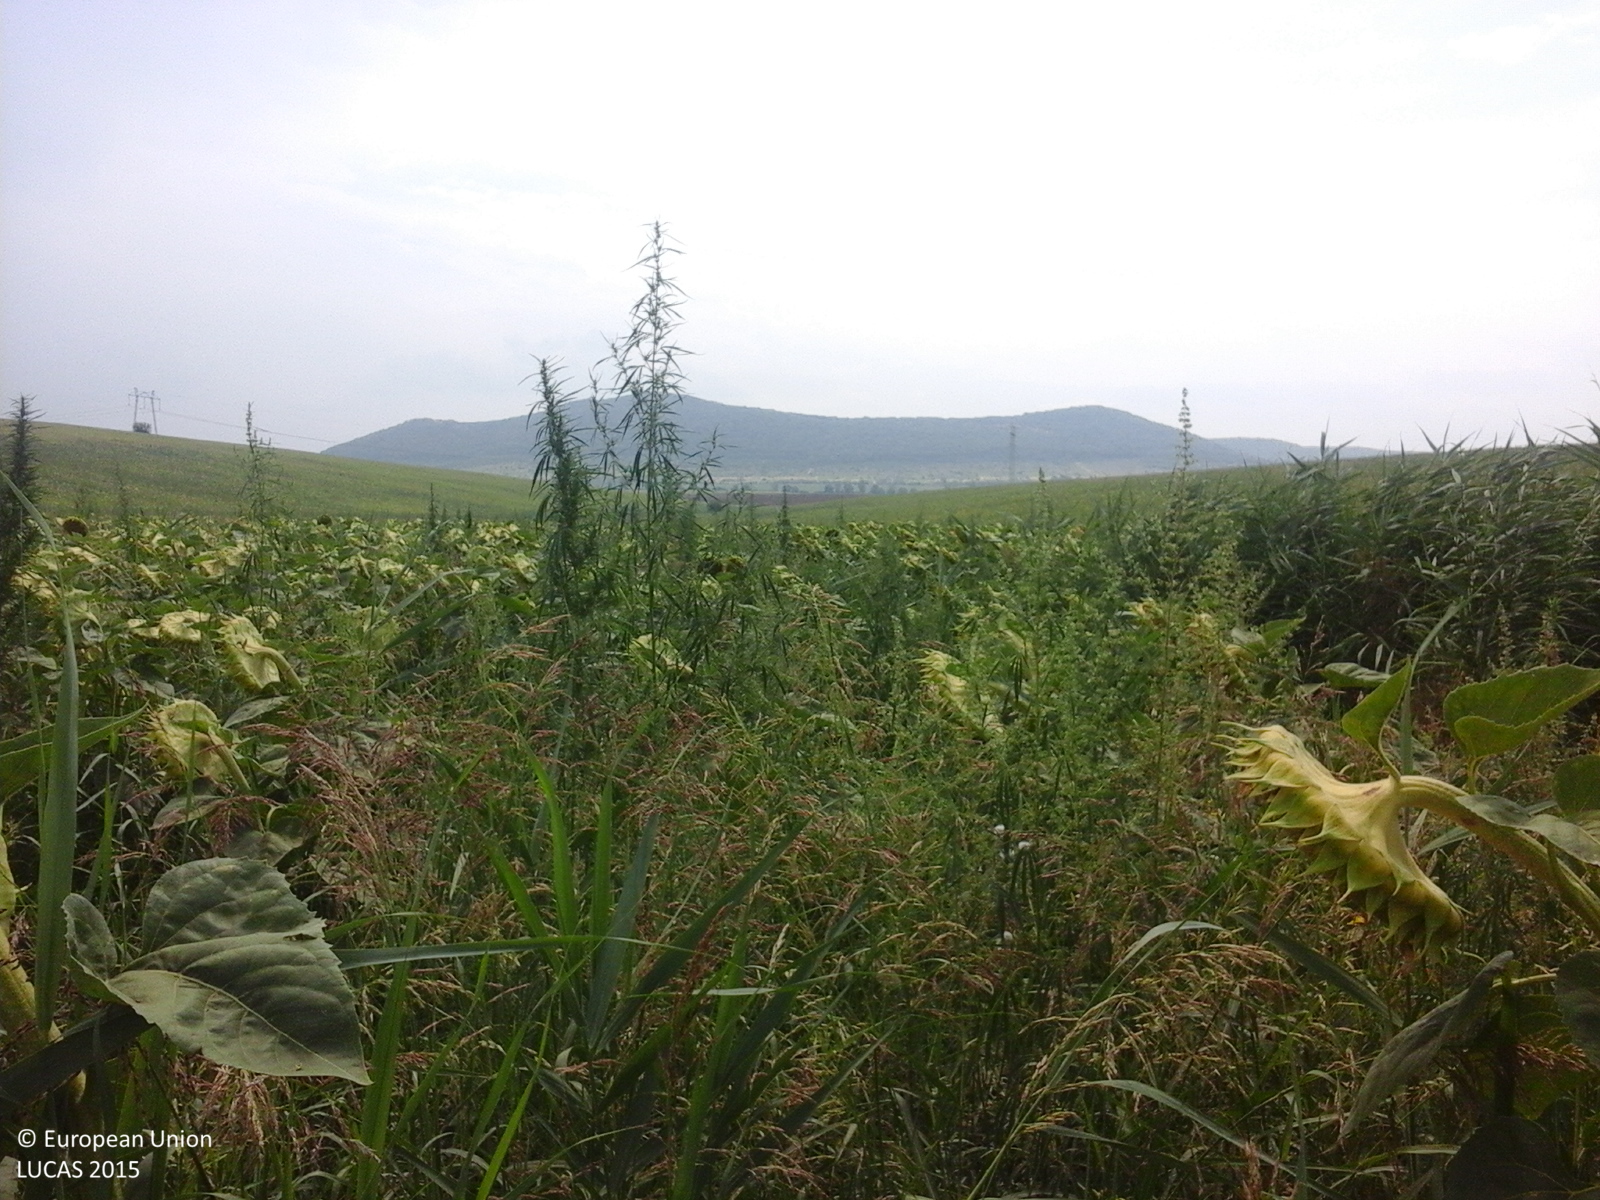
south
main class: Cropland
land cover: Sunflower
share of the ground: > 75 %
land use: Agriculture (excluding fallow land and kitchen gardens)
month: July
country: RO
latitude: 45.2119
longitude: 28.5311
